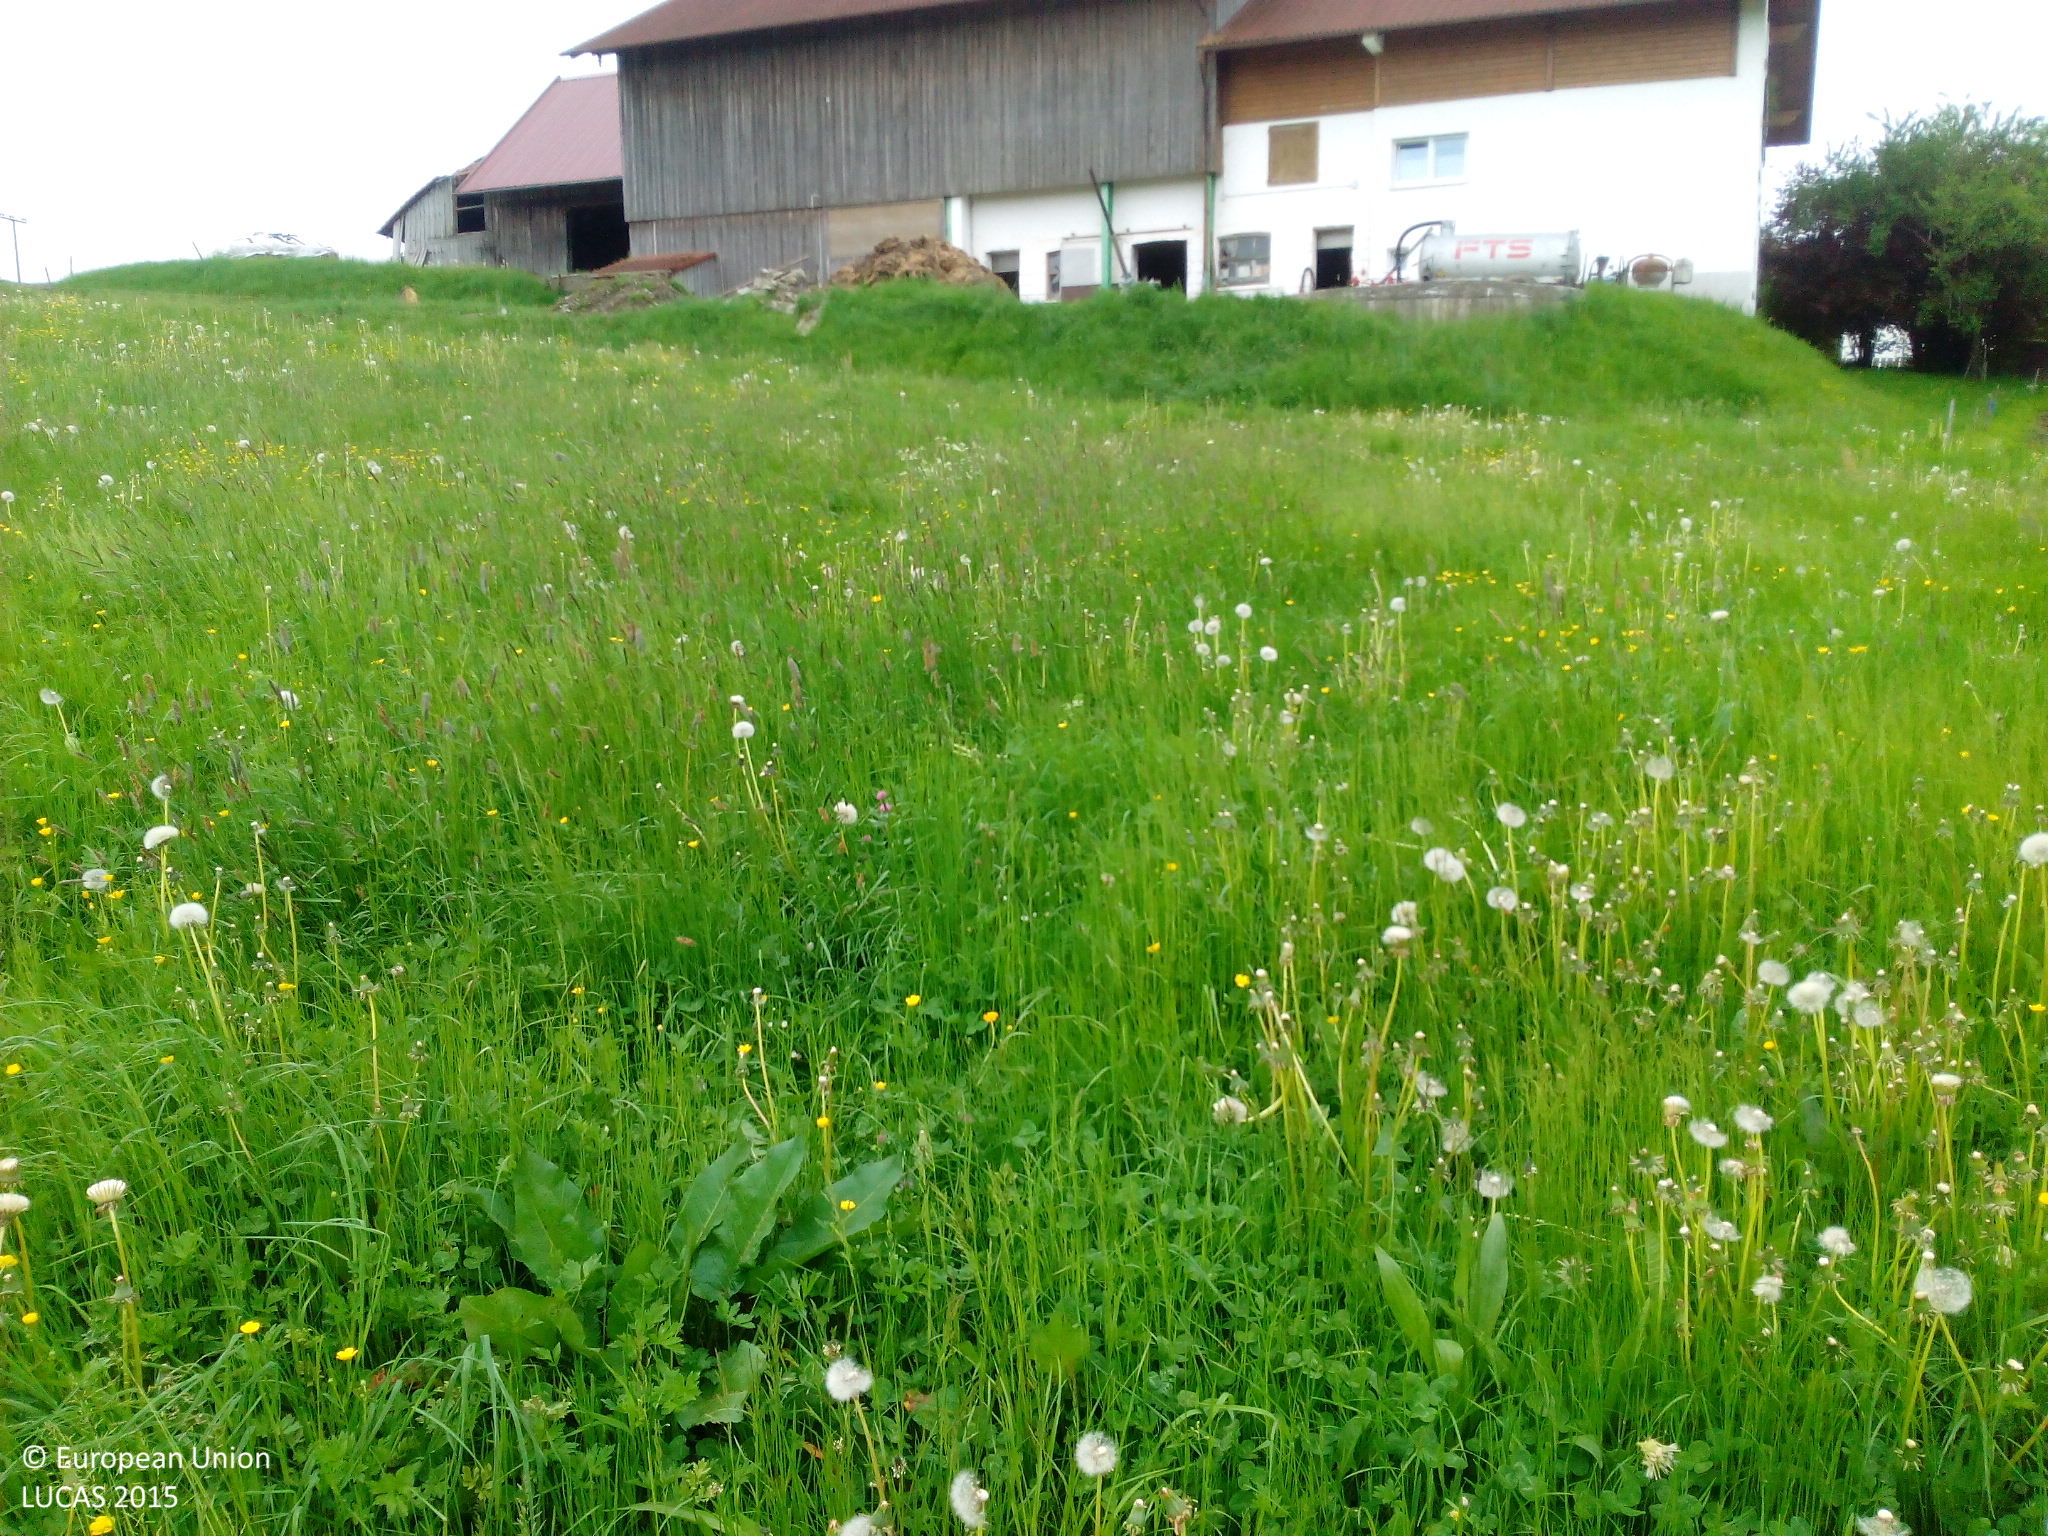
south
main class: Grassland
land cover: Grassland without tree/shrub cover
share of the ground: > 75 %
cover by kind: herbaceous plants 100 %
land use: Agriculture (excluding fallow land and kitchen gardens)
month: May
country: DE
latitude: 47.7916
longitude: 9.9333
